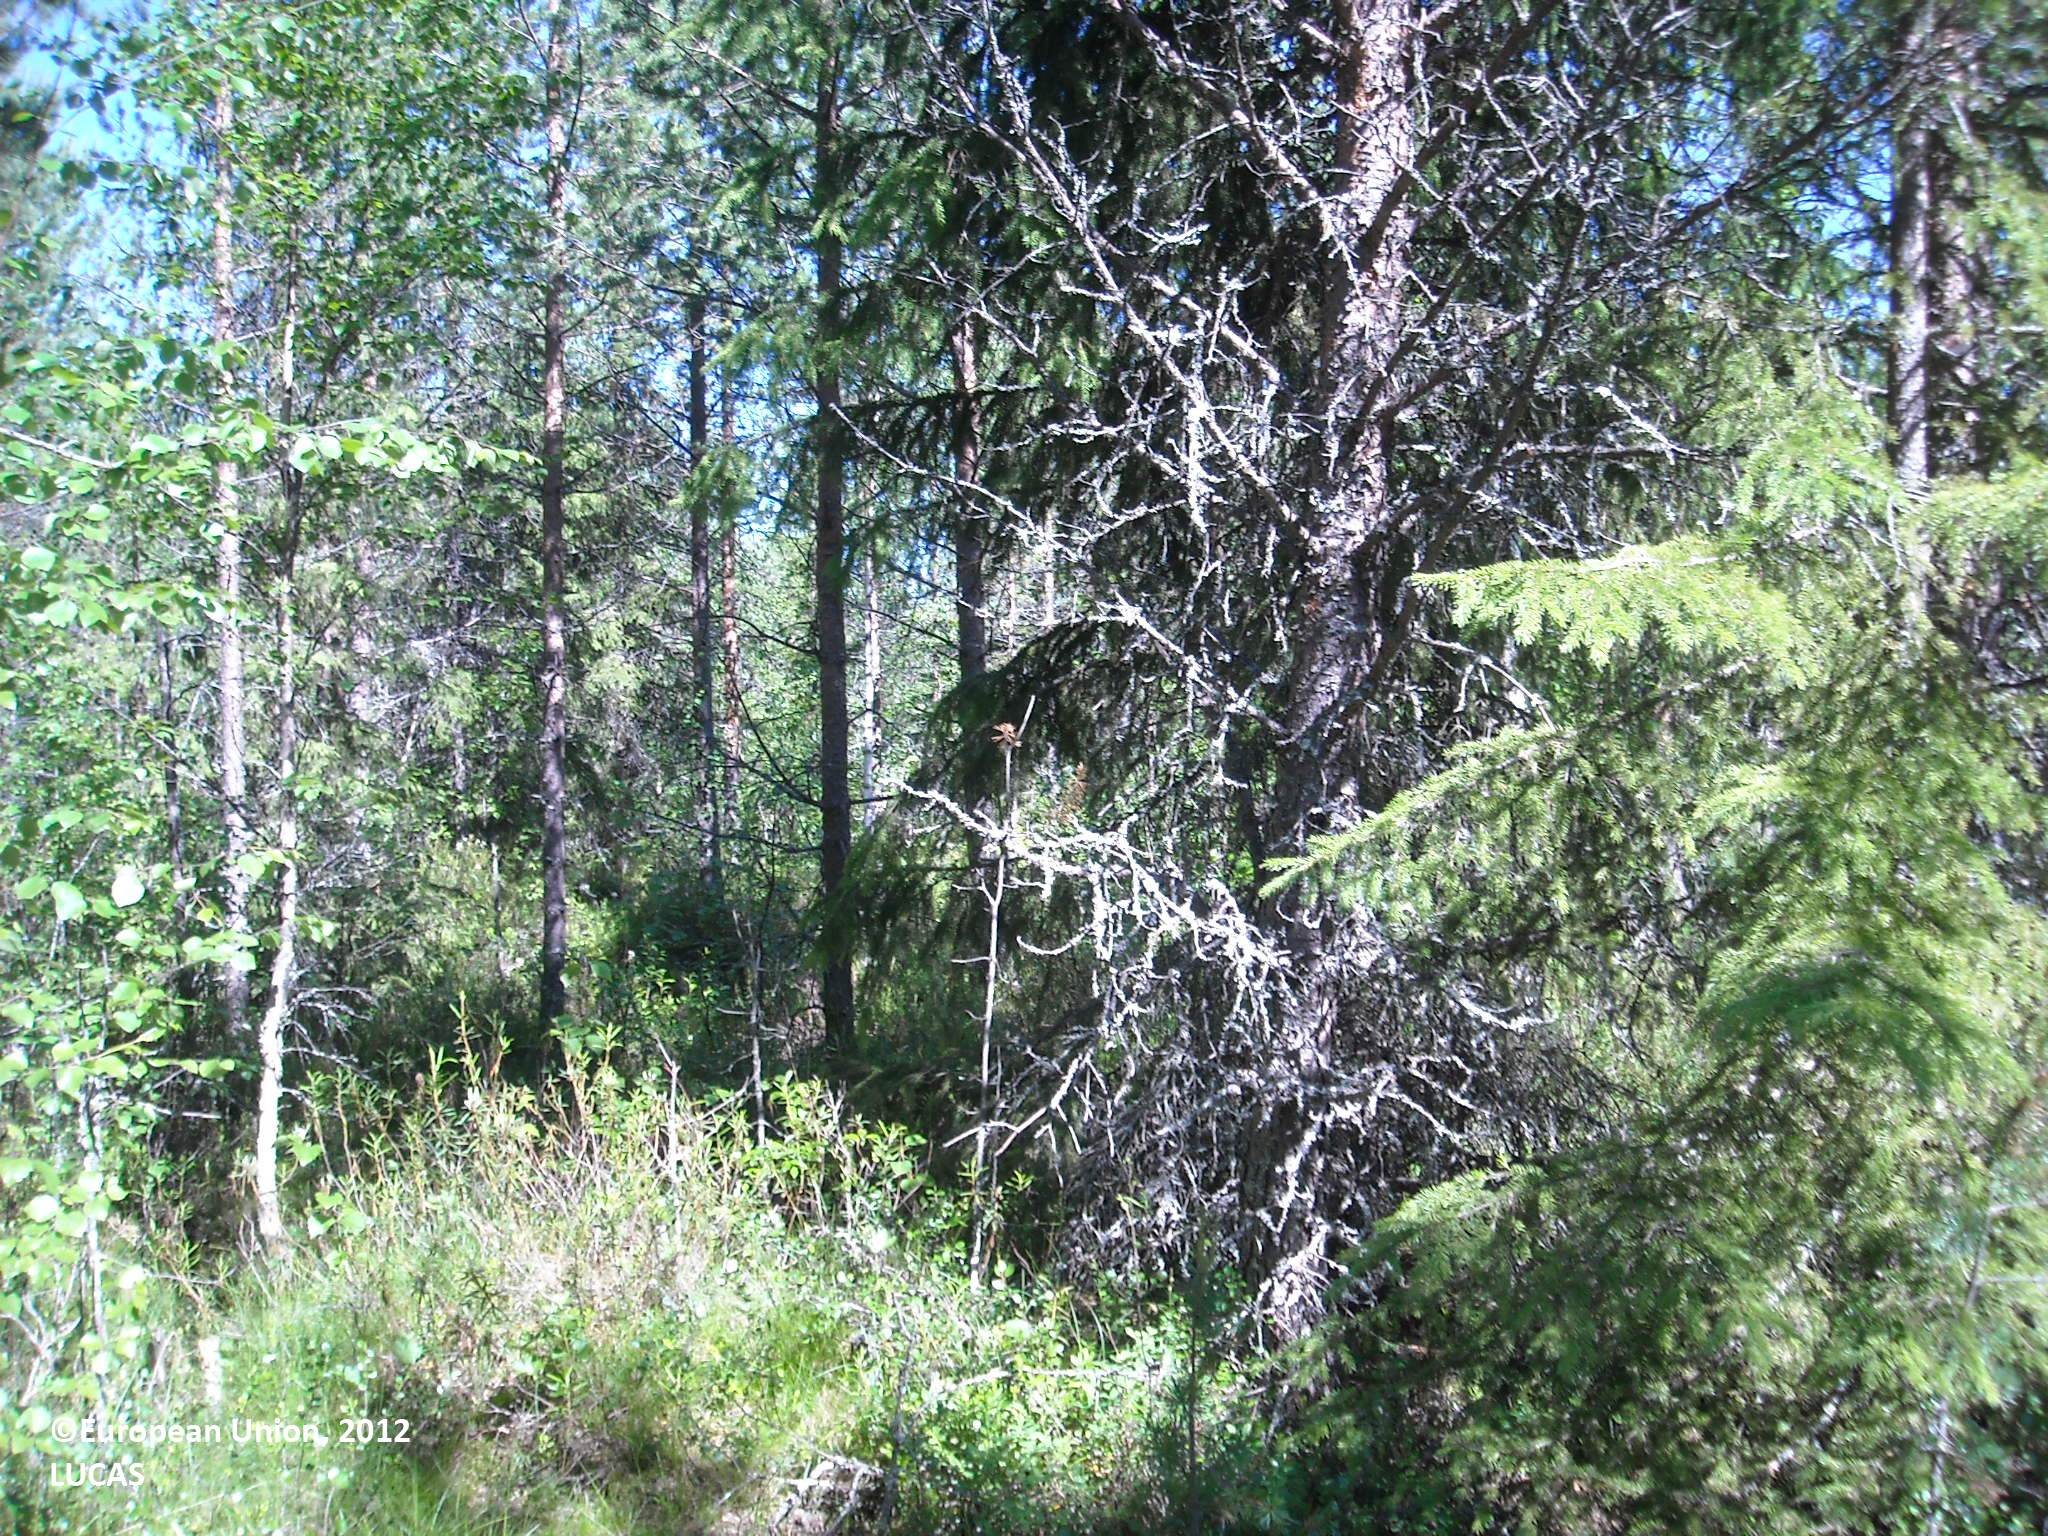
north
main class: Woodland
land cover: Other mixed woodland
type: boreal forest
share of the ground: > 75 %
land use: Forestry
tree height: > 5 m
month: July
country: FI
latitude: 64.9130
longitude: 27.4044
